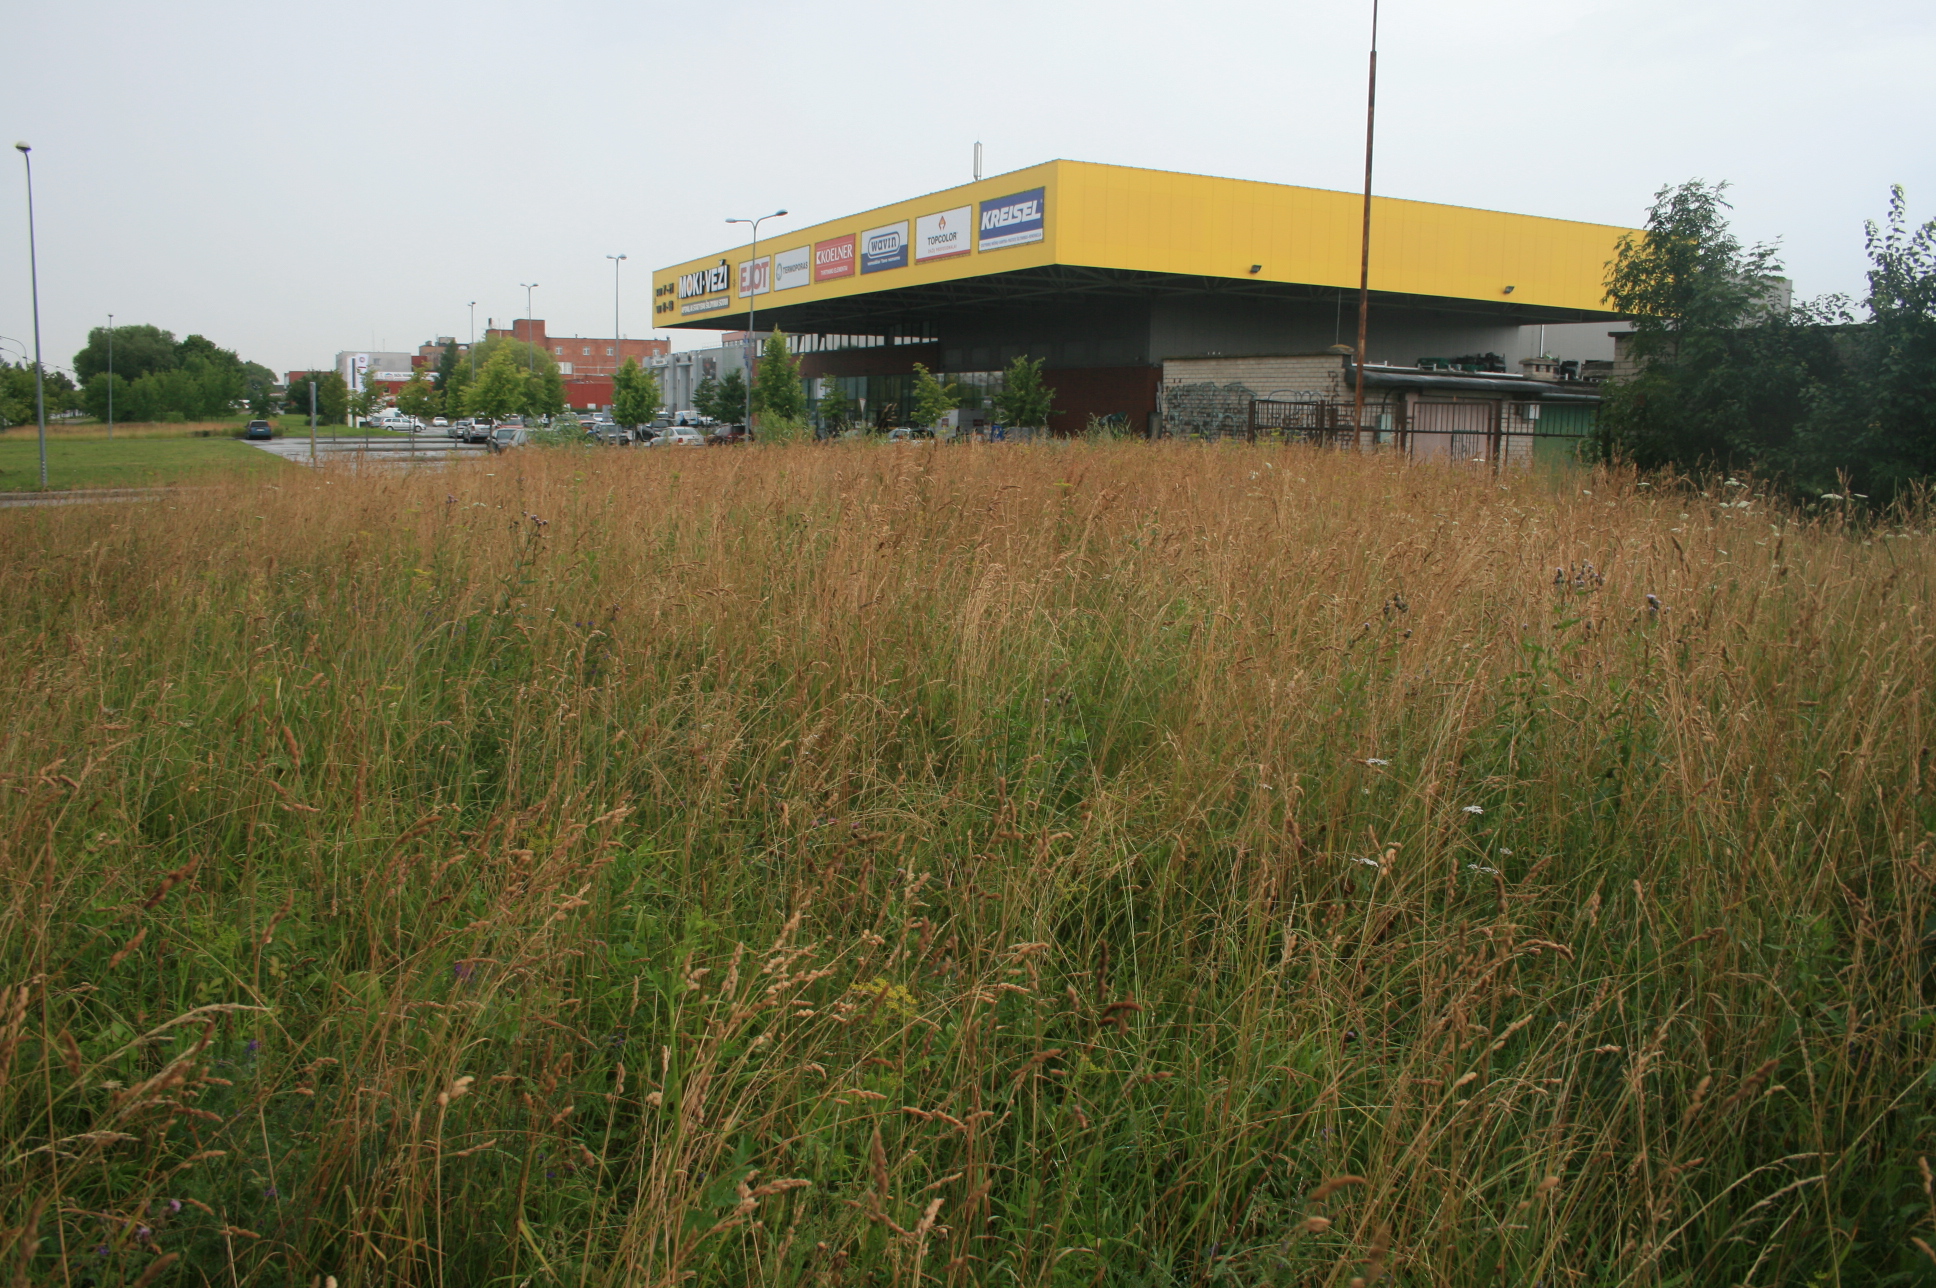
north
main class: Grassland
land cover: Grassland without tree/shrub cover
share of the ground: > 75 %
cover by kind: herbaceous plants 100 %
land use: Residential
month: July
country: LT
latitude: 55.6786
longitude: 21.1889
